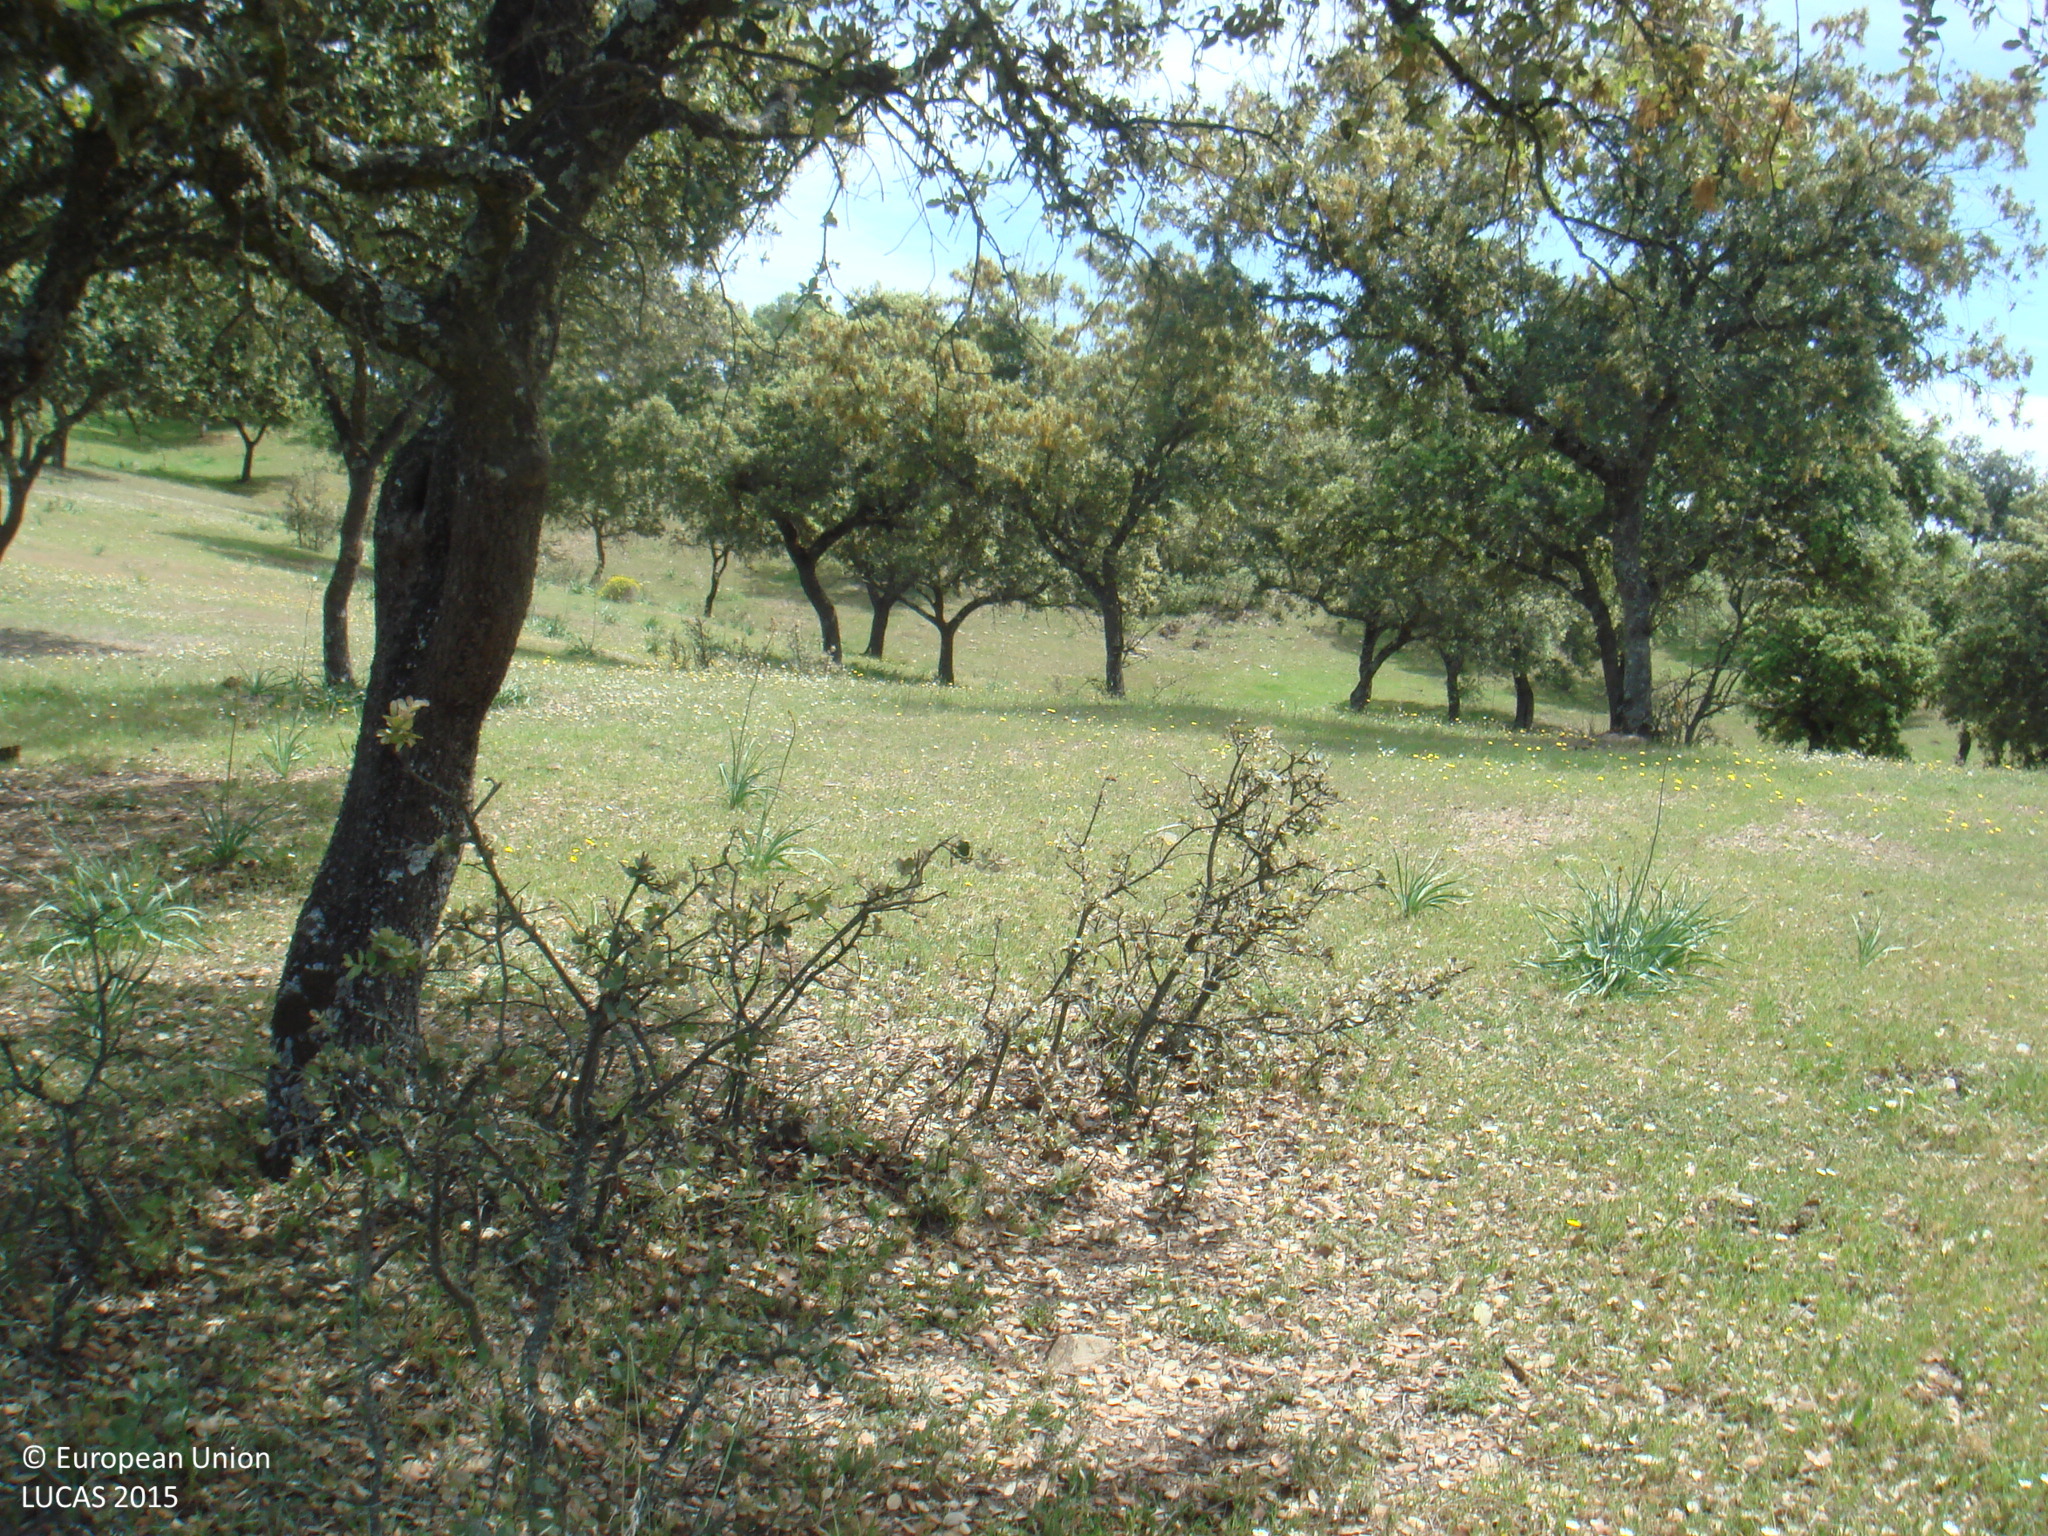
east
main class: Woodland
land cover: Broadleaved woodland
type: broadleaved evergreen forest
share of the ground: > 75 %
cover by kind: broadleaved forest trees 80 %, coniferous forest trees 20 %
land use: Forestry
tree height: > 5 m
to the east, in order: Broadleaved woodland; Grassland with sparse tree/shrub cover; Fences; Broadleaved woodland
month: April
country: ES
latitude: 38.1817
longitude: -4.6879
